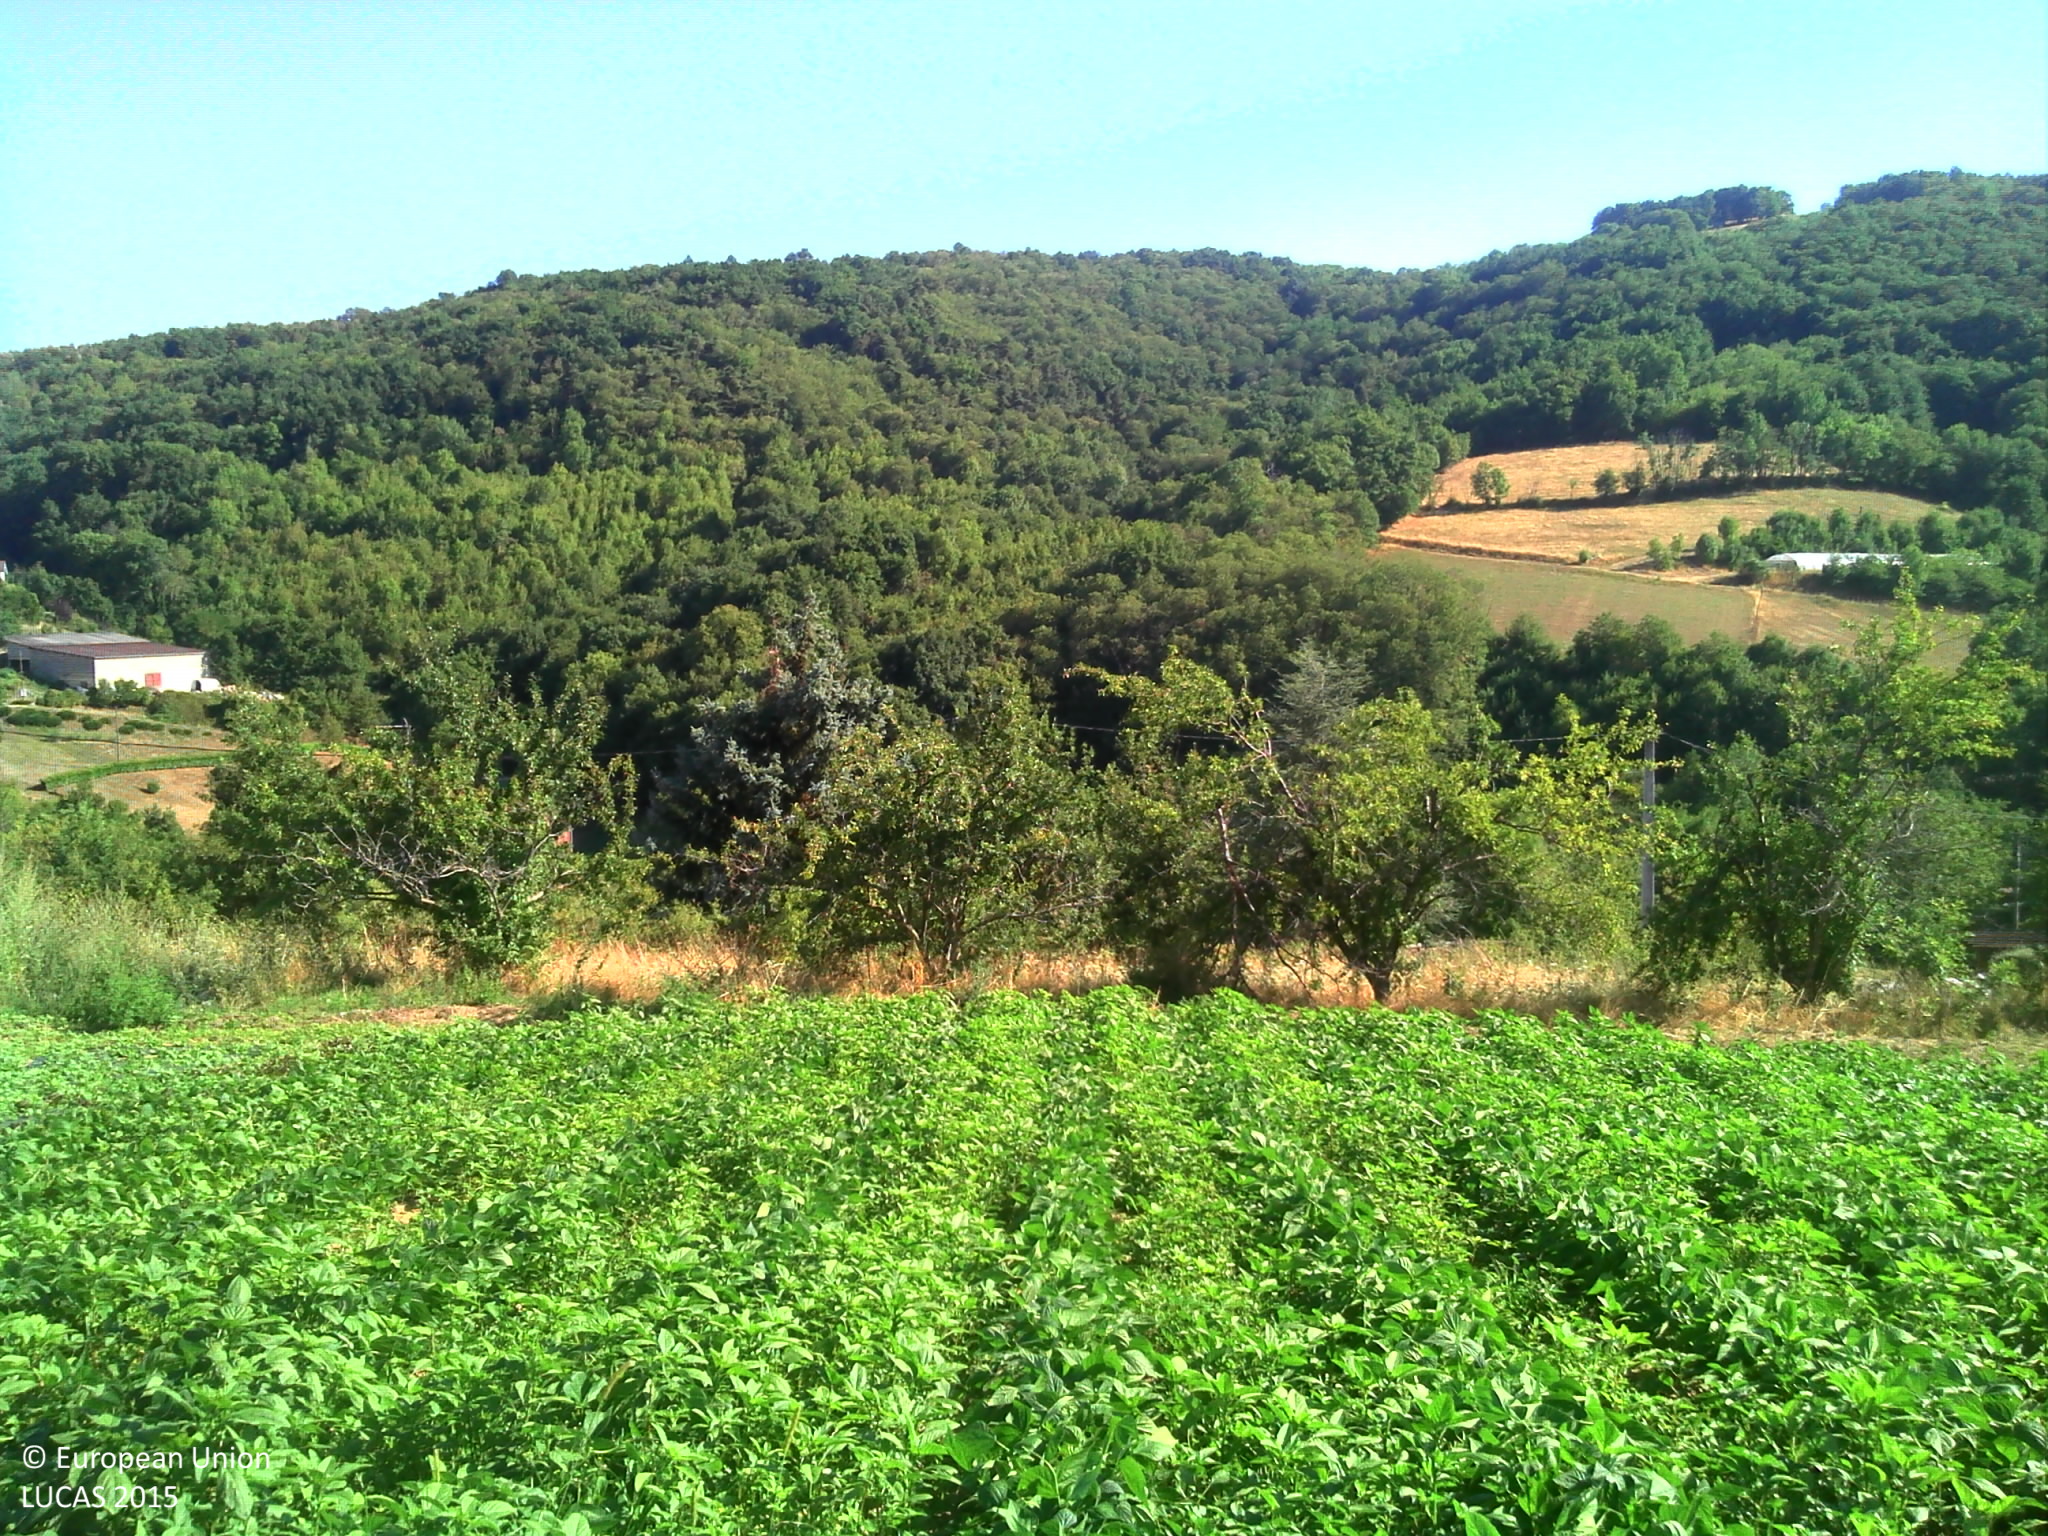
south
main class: Cropland
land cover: Dry pulses
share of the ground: > 75 %
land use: Agriculture (excluding fallow land and kitchen gardens)
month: August
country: FR
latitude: 45.6745
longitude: 4.6247
